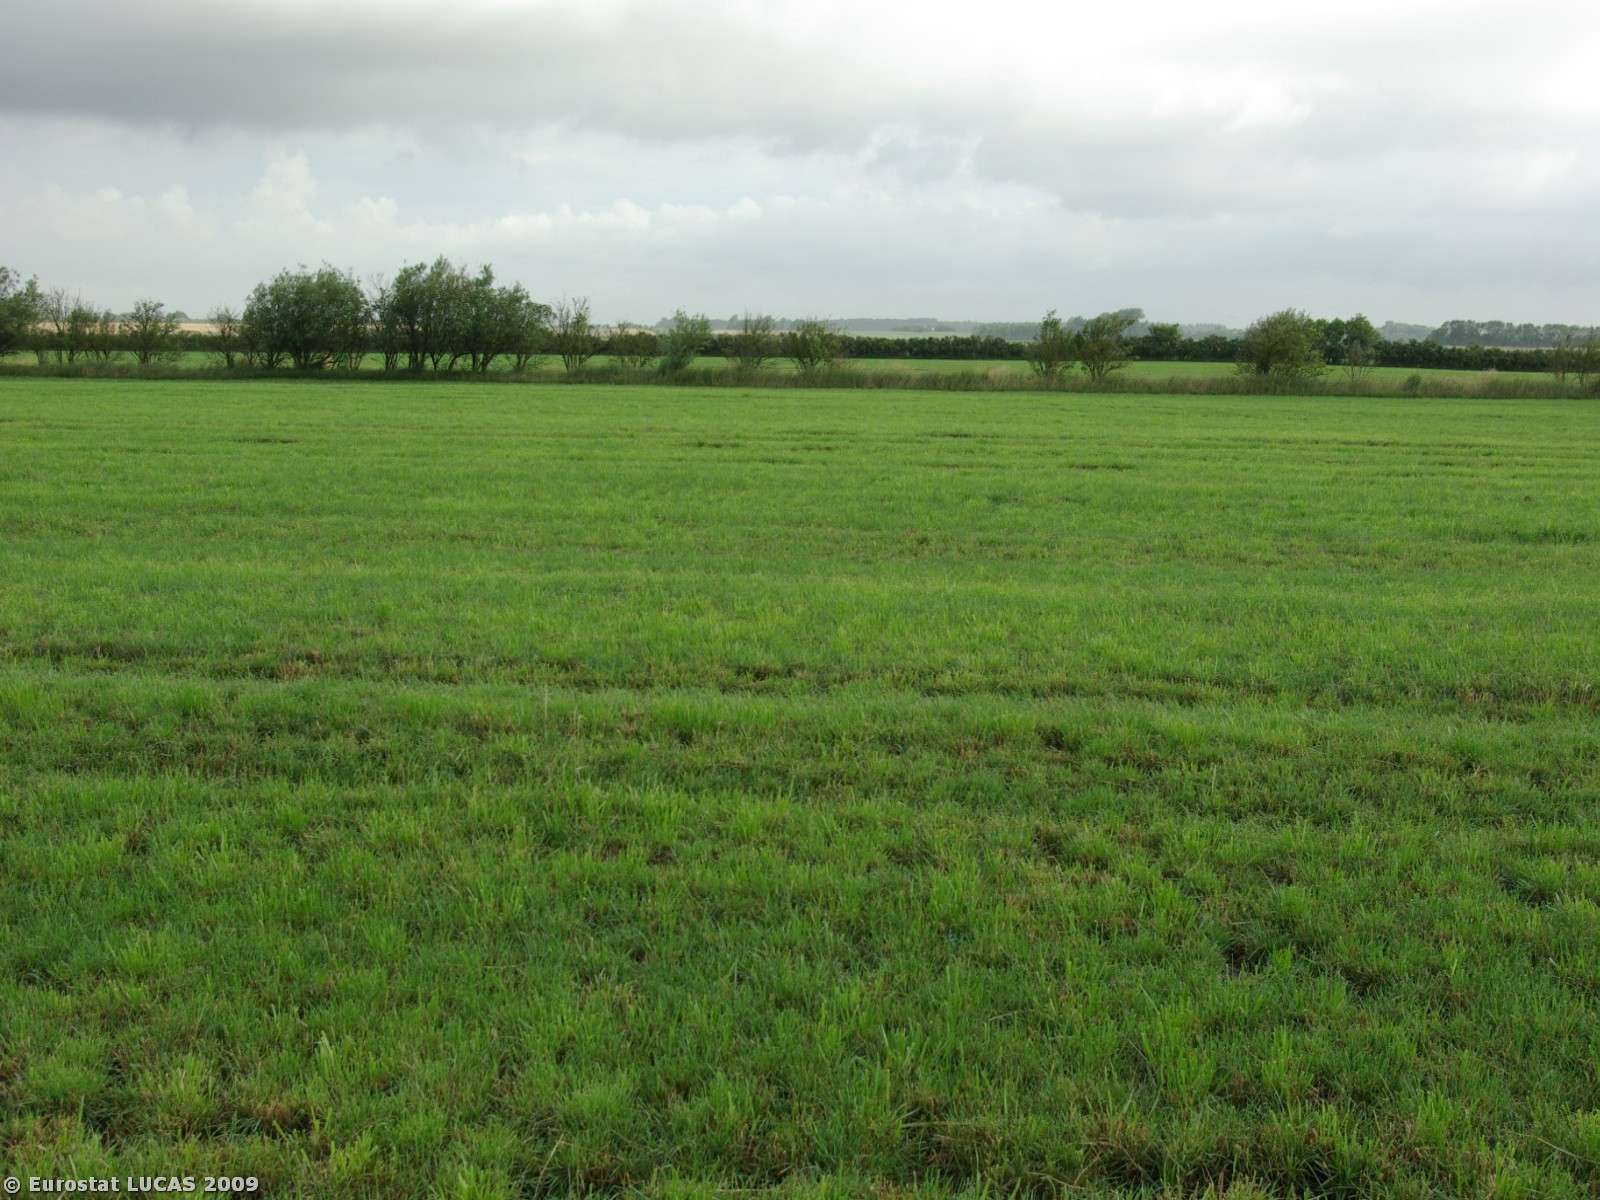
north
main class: Grassland
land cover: Grassland without tree/shrub cover
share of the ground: > 75 %
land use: Agriculture (excluding fallow land and kitchen gardens)
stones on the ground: < 10 %
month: July
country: DK
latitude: 54.9241
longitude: 8.8306
